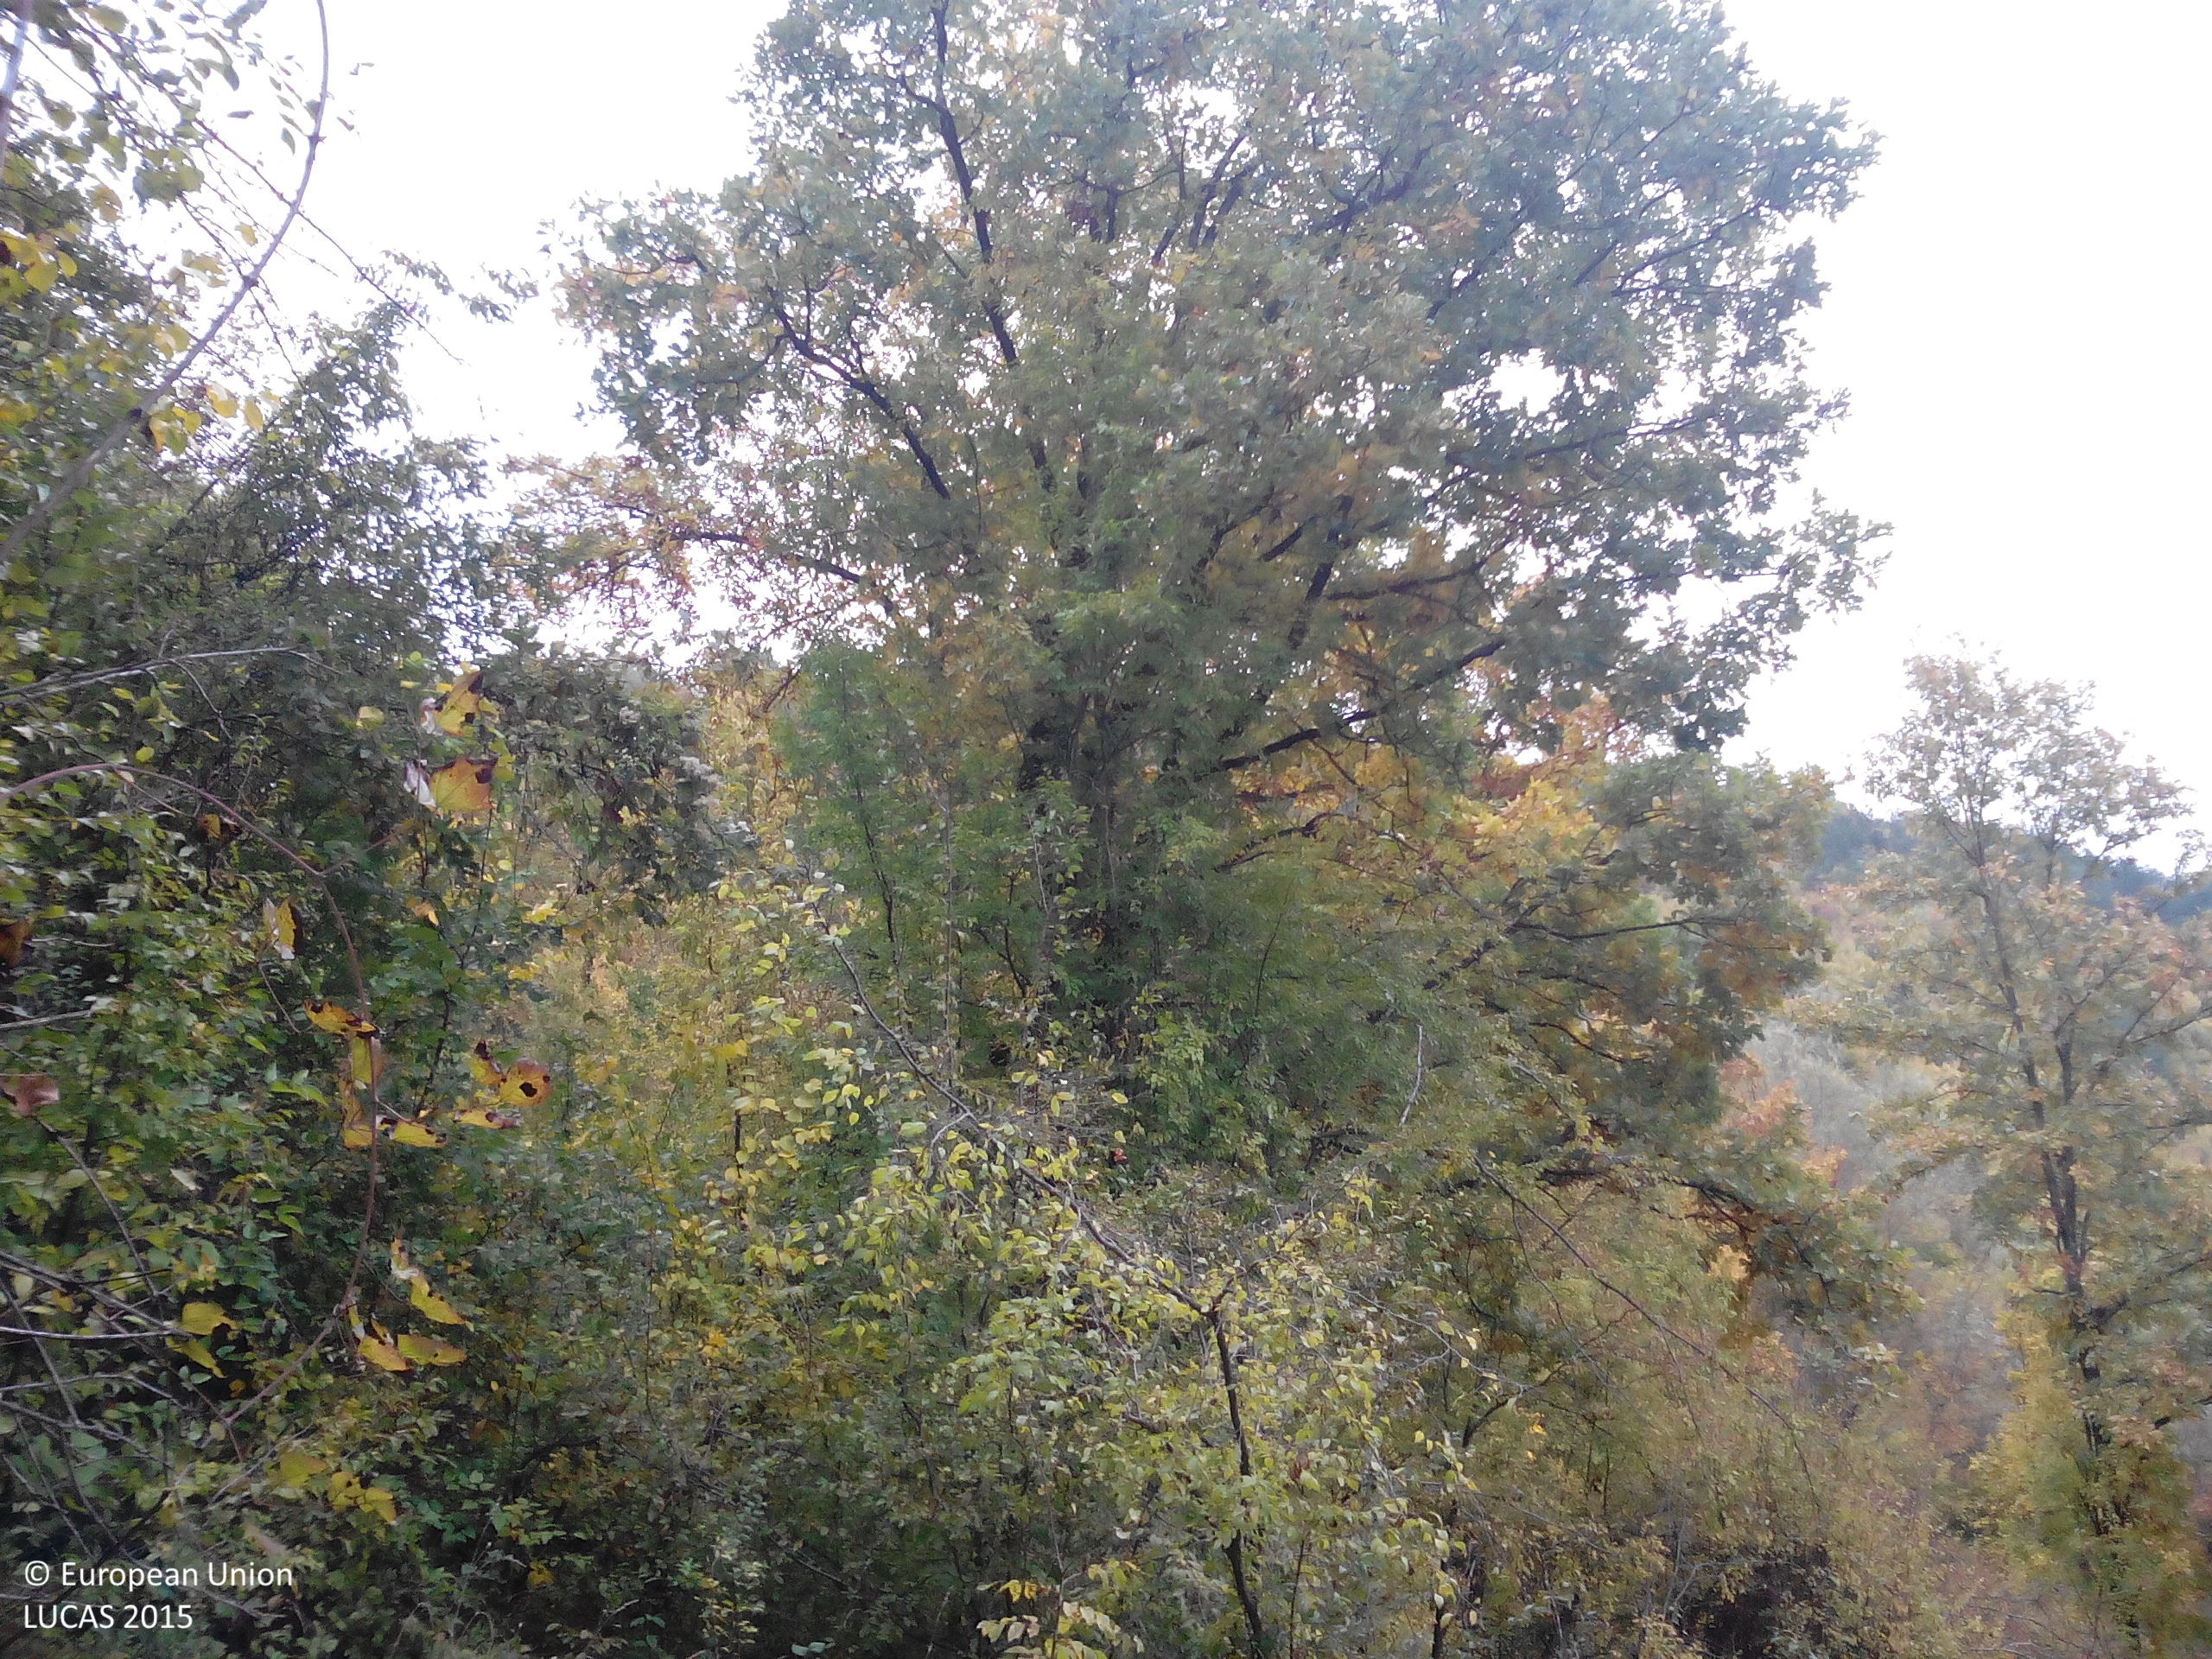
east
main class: Woodland
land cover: Broadleaved woodland
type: mesophytic deciduous forest
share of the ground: > 75 %
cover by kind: broadleaved forest trees 80 %, shrubs 10 %, herbaceous plants 10 %
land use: Abandoned areas
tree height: > 5 m
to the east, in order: Broadleaved woodland; Tracks; Broadleaved woodland
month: October
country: BG
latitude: 43.0123
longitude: 23.9980
